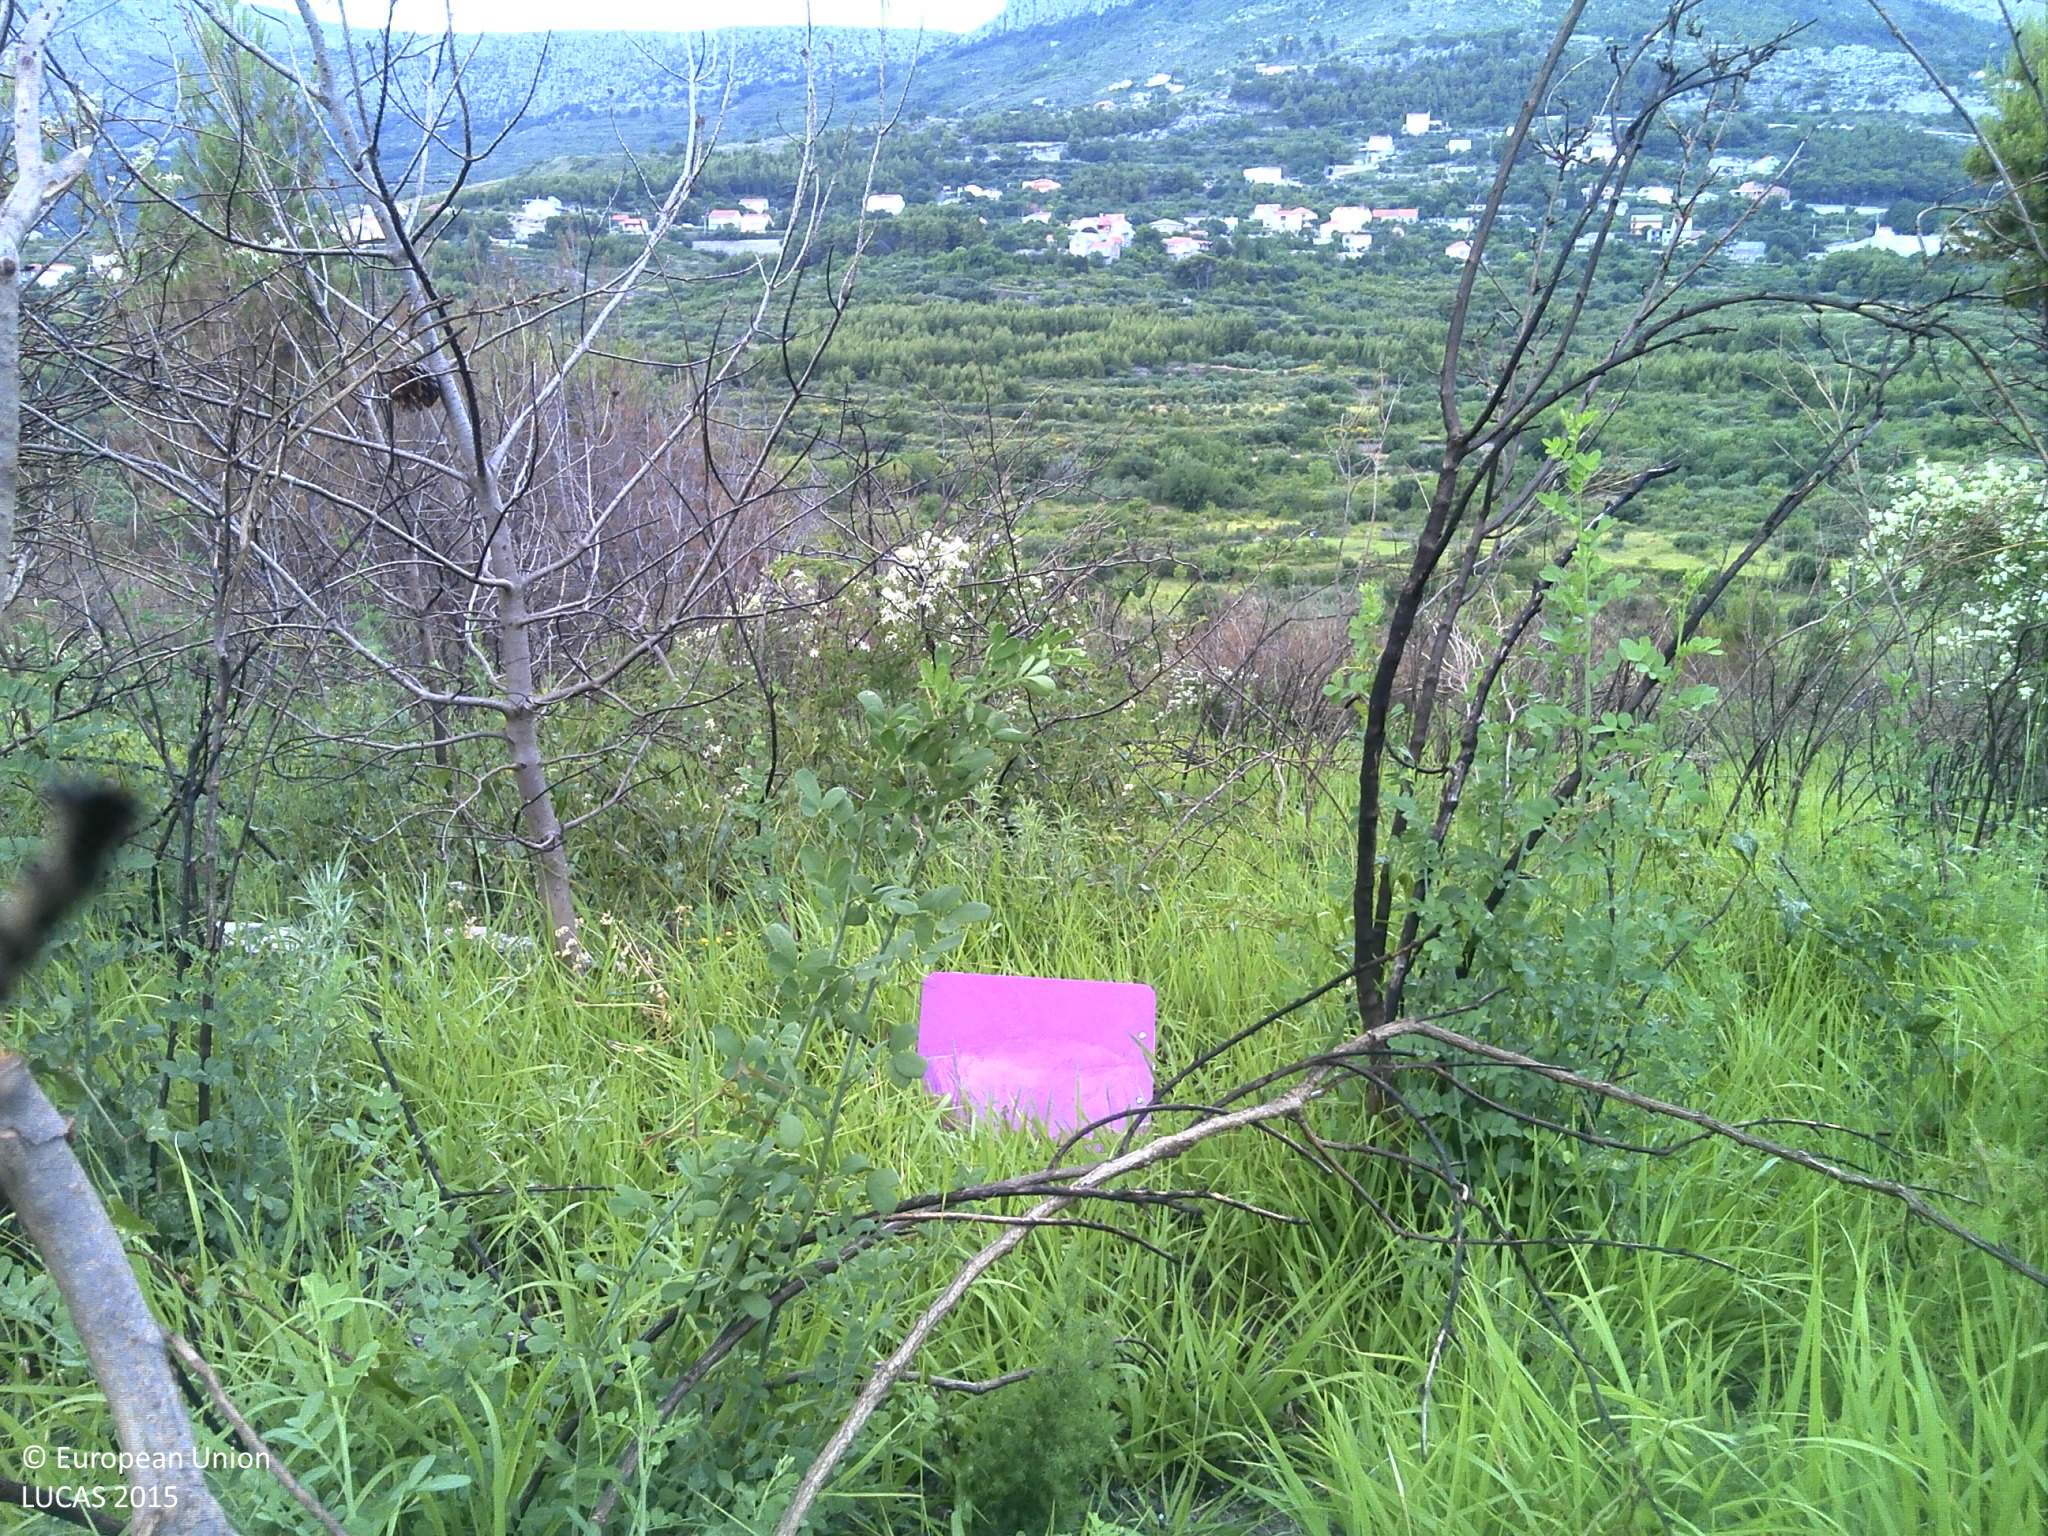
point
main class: Grassland
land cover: Spontaneously vegetated surfaces
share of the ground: > 75 %
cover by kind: herbaceous plants 80 %, shrubs 5 %, lichens and mosses 5 %, consolidated bare surface 5 %, unconsolidated bare surface 5 %
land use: Semi-natural and natural areas not in use
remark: Burnt area
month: June
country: HR
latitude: 43.5487
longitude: 16.5140
